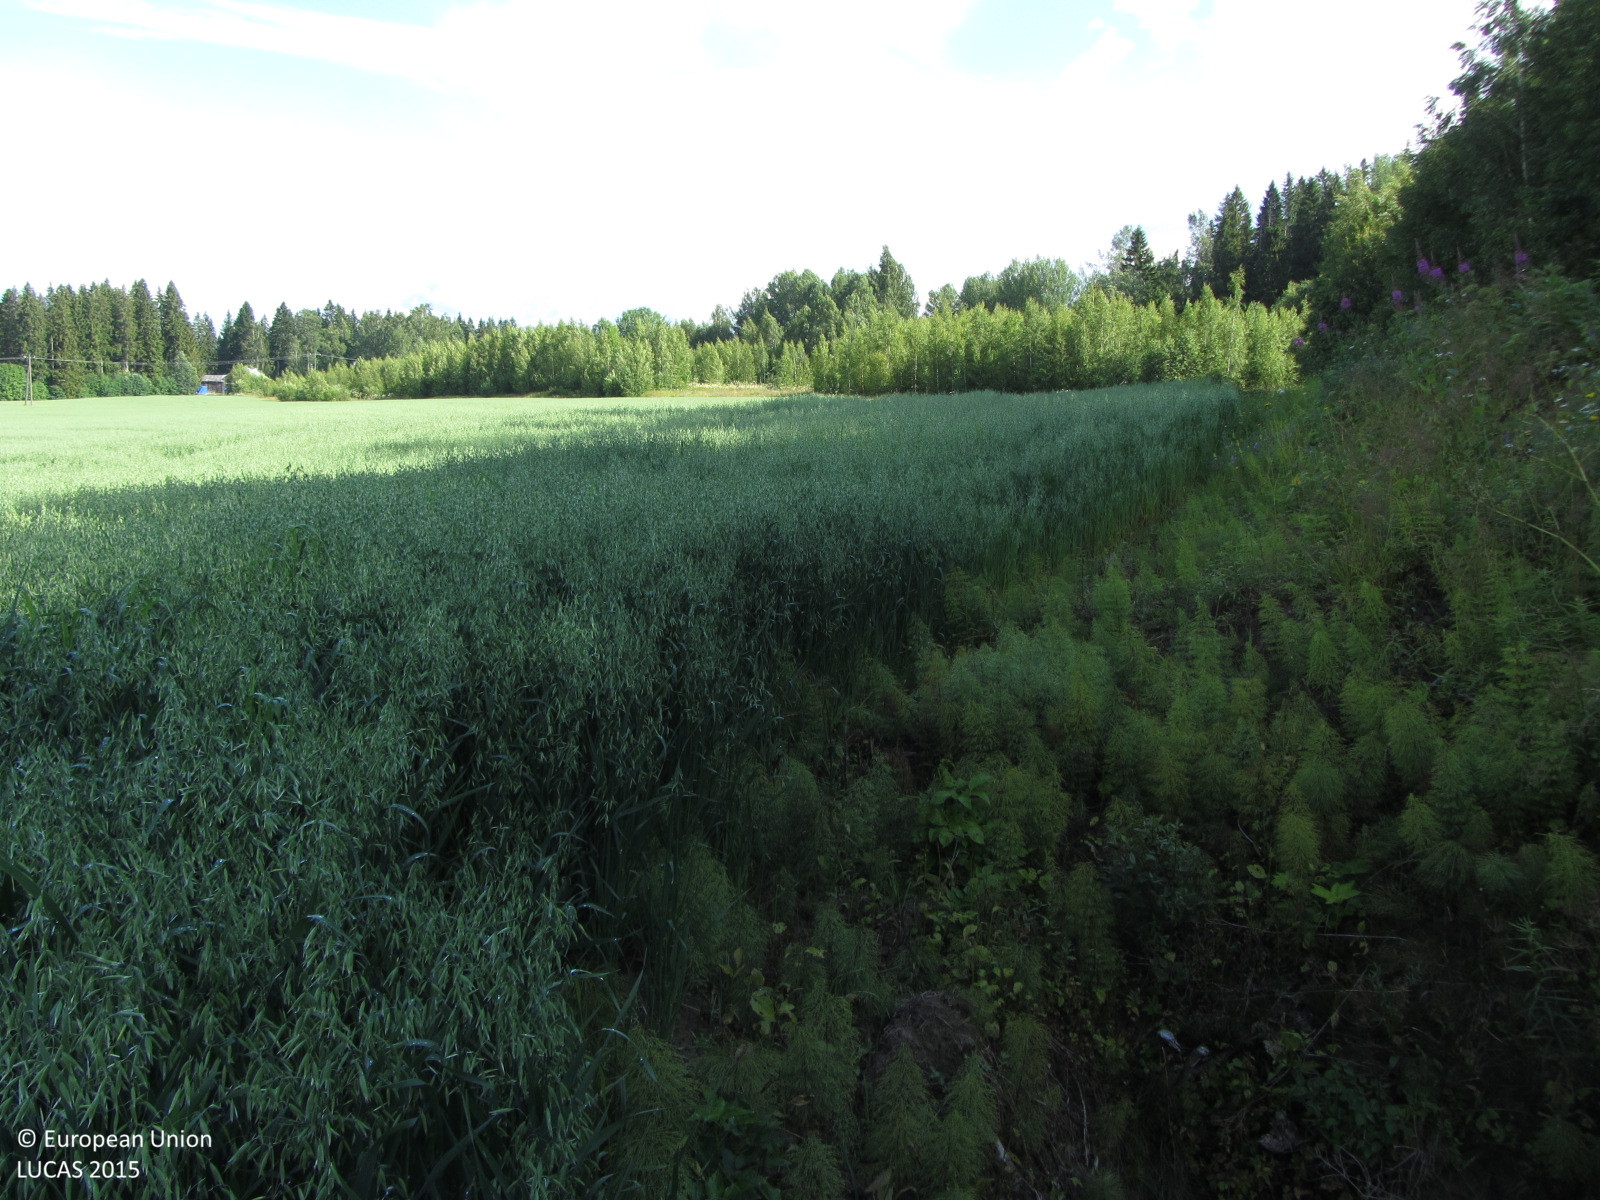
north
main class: Cropland
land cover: Oats
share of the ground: > 75 %
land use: Agriculture (excluding fallow land and kitchen gardens)
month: July
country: FI
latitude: 60.5082
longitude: 24.3247
